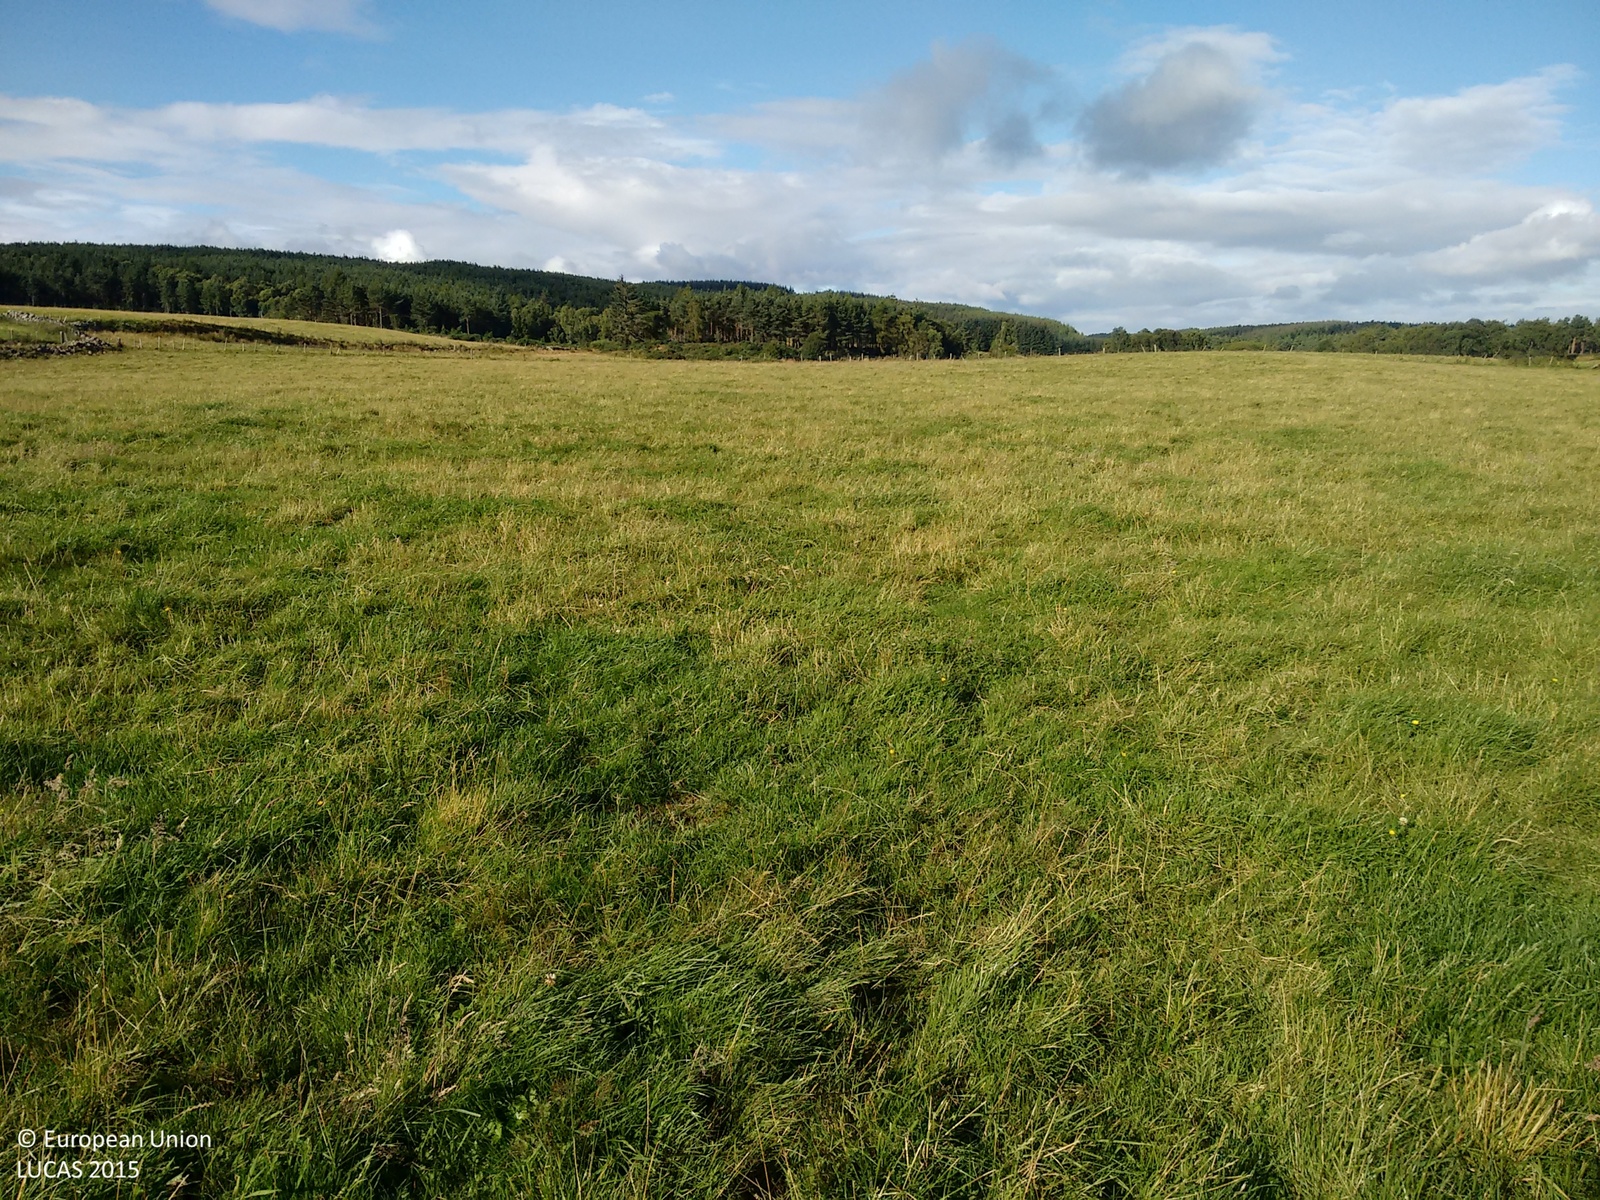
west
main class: Grassland
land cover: Grassland without tree/shrub cover
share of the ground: > 75 %
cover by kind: herbaceous plants 100 %
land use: Agriculture (excluding fallow land and kitchen gardens)
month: August
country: GB
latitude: 57.5501
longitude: -3.5222
